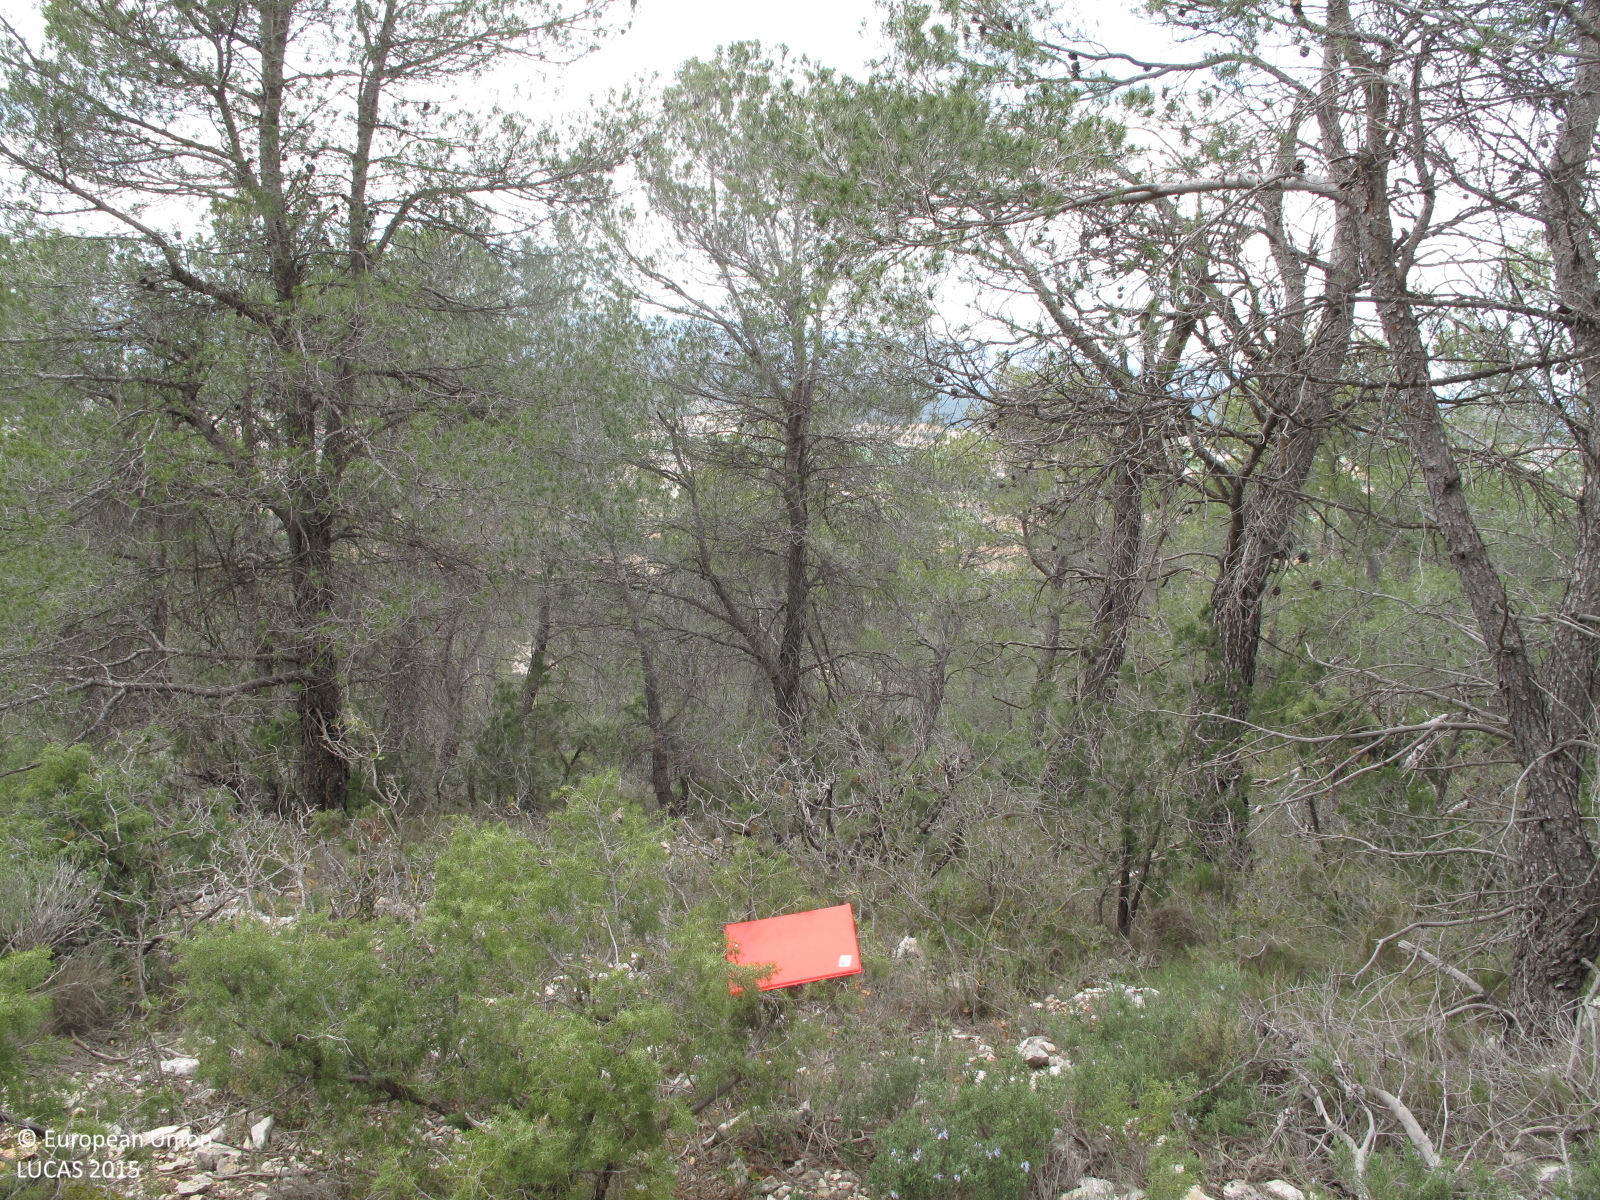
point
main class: Woodland
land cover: Pine dominated coniferous woodland
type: coniferous forest of the mediterranean region
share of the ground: 50 - 75 %
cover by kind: coniferous forest trees 60 %, consolidated bare surface 20 %, shrubs 10 %, herbaceous plants 10 %
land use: Semi-natural and natural areas not in use
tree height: > 5 m
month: March
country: ES
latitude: 38.7597
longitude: -0.7742
